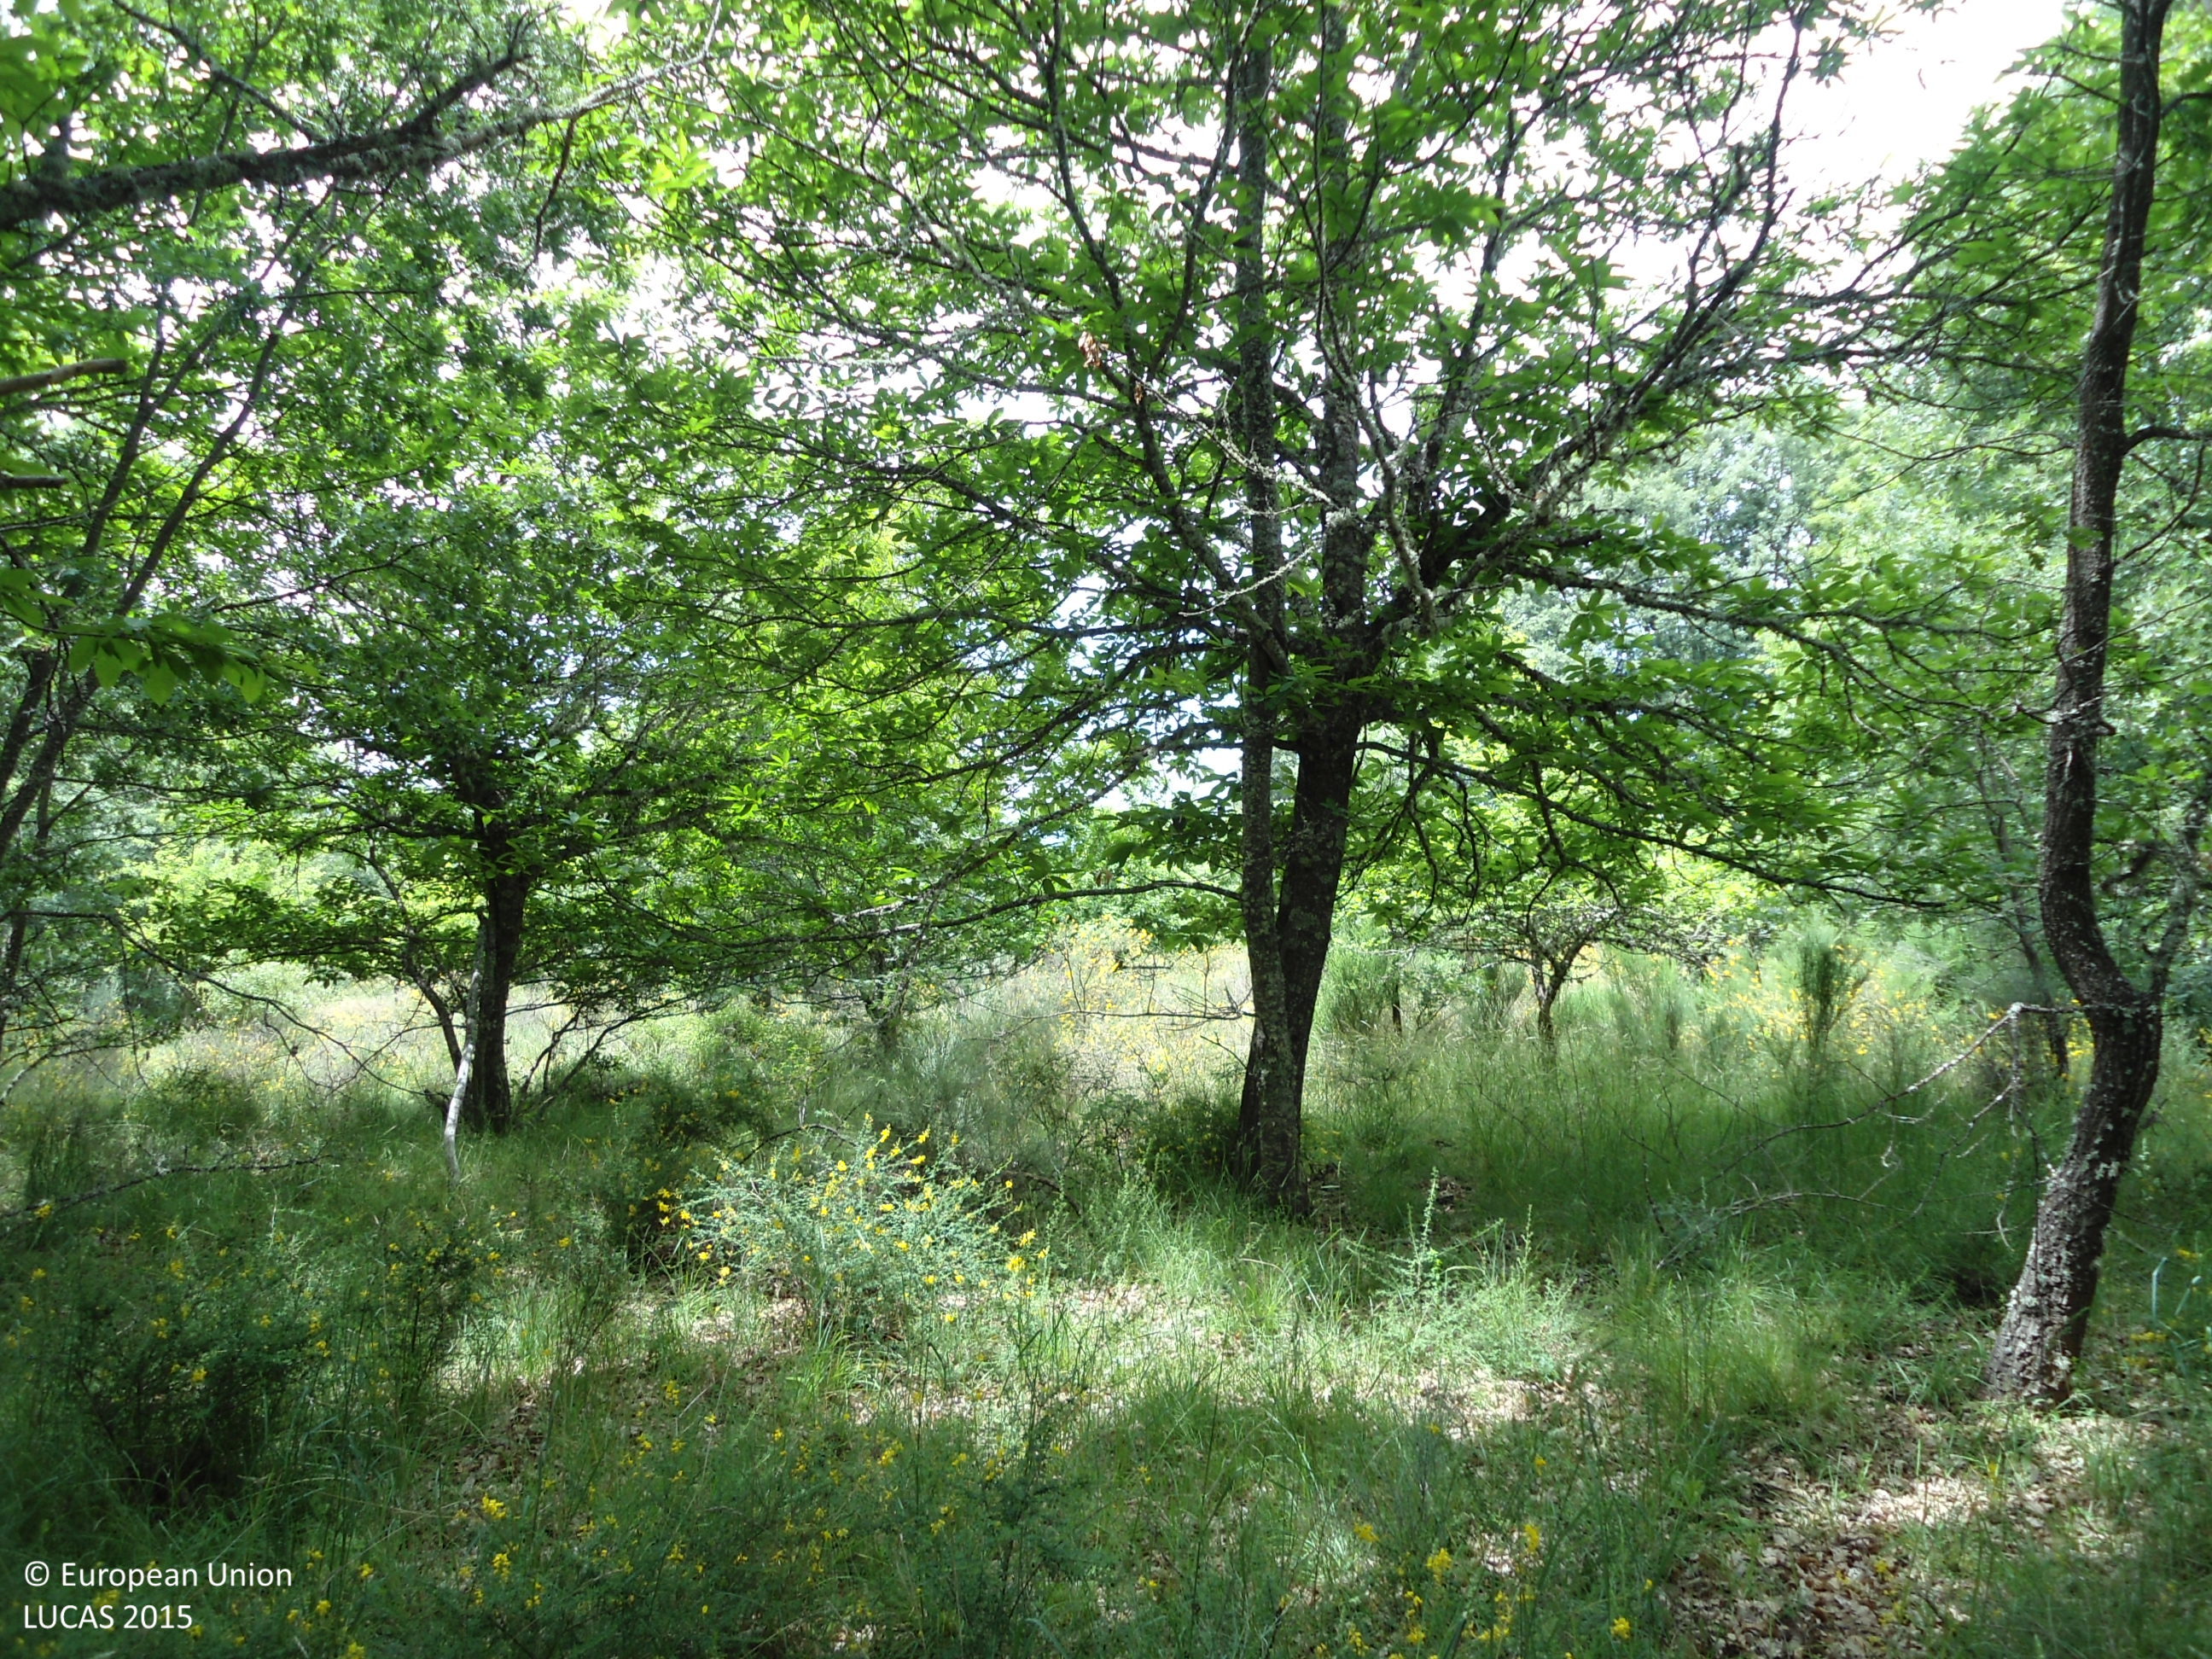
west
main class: Woodland
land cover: Broadleaved woodland
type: thermophilous deciduous forest
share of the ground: > 75 %
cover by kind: broadleaved forest trees 100 %
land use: Forestry
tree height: > 5 m
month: June
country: ES
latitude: 42.0842
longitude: -6.5901
